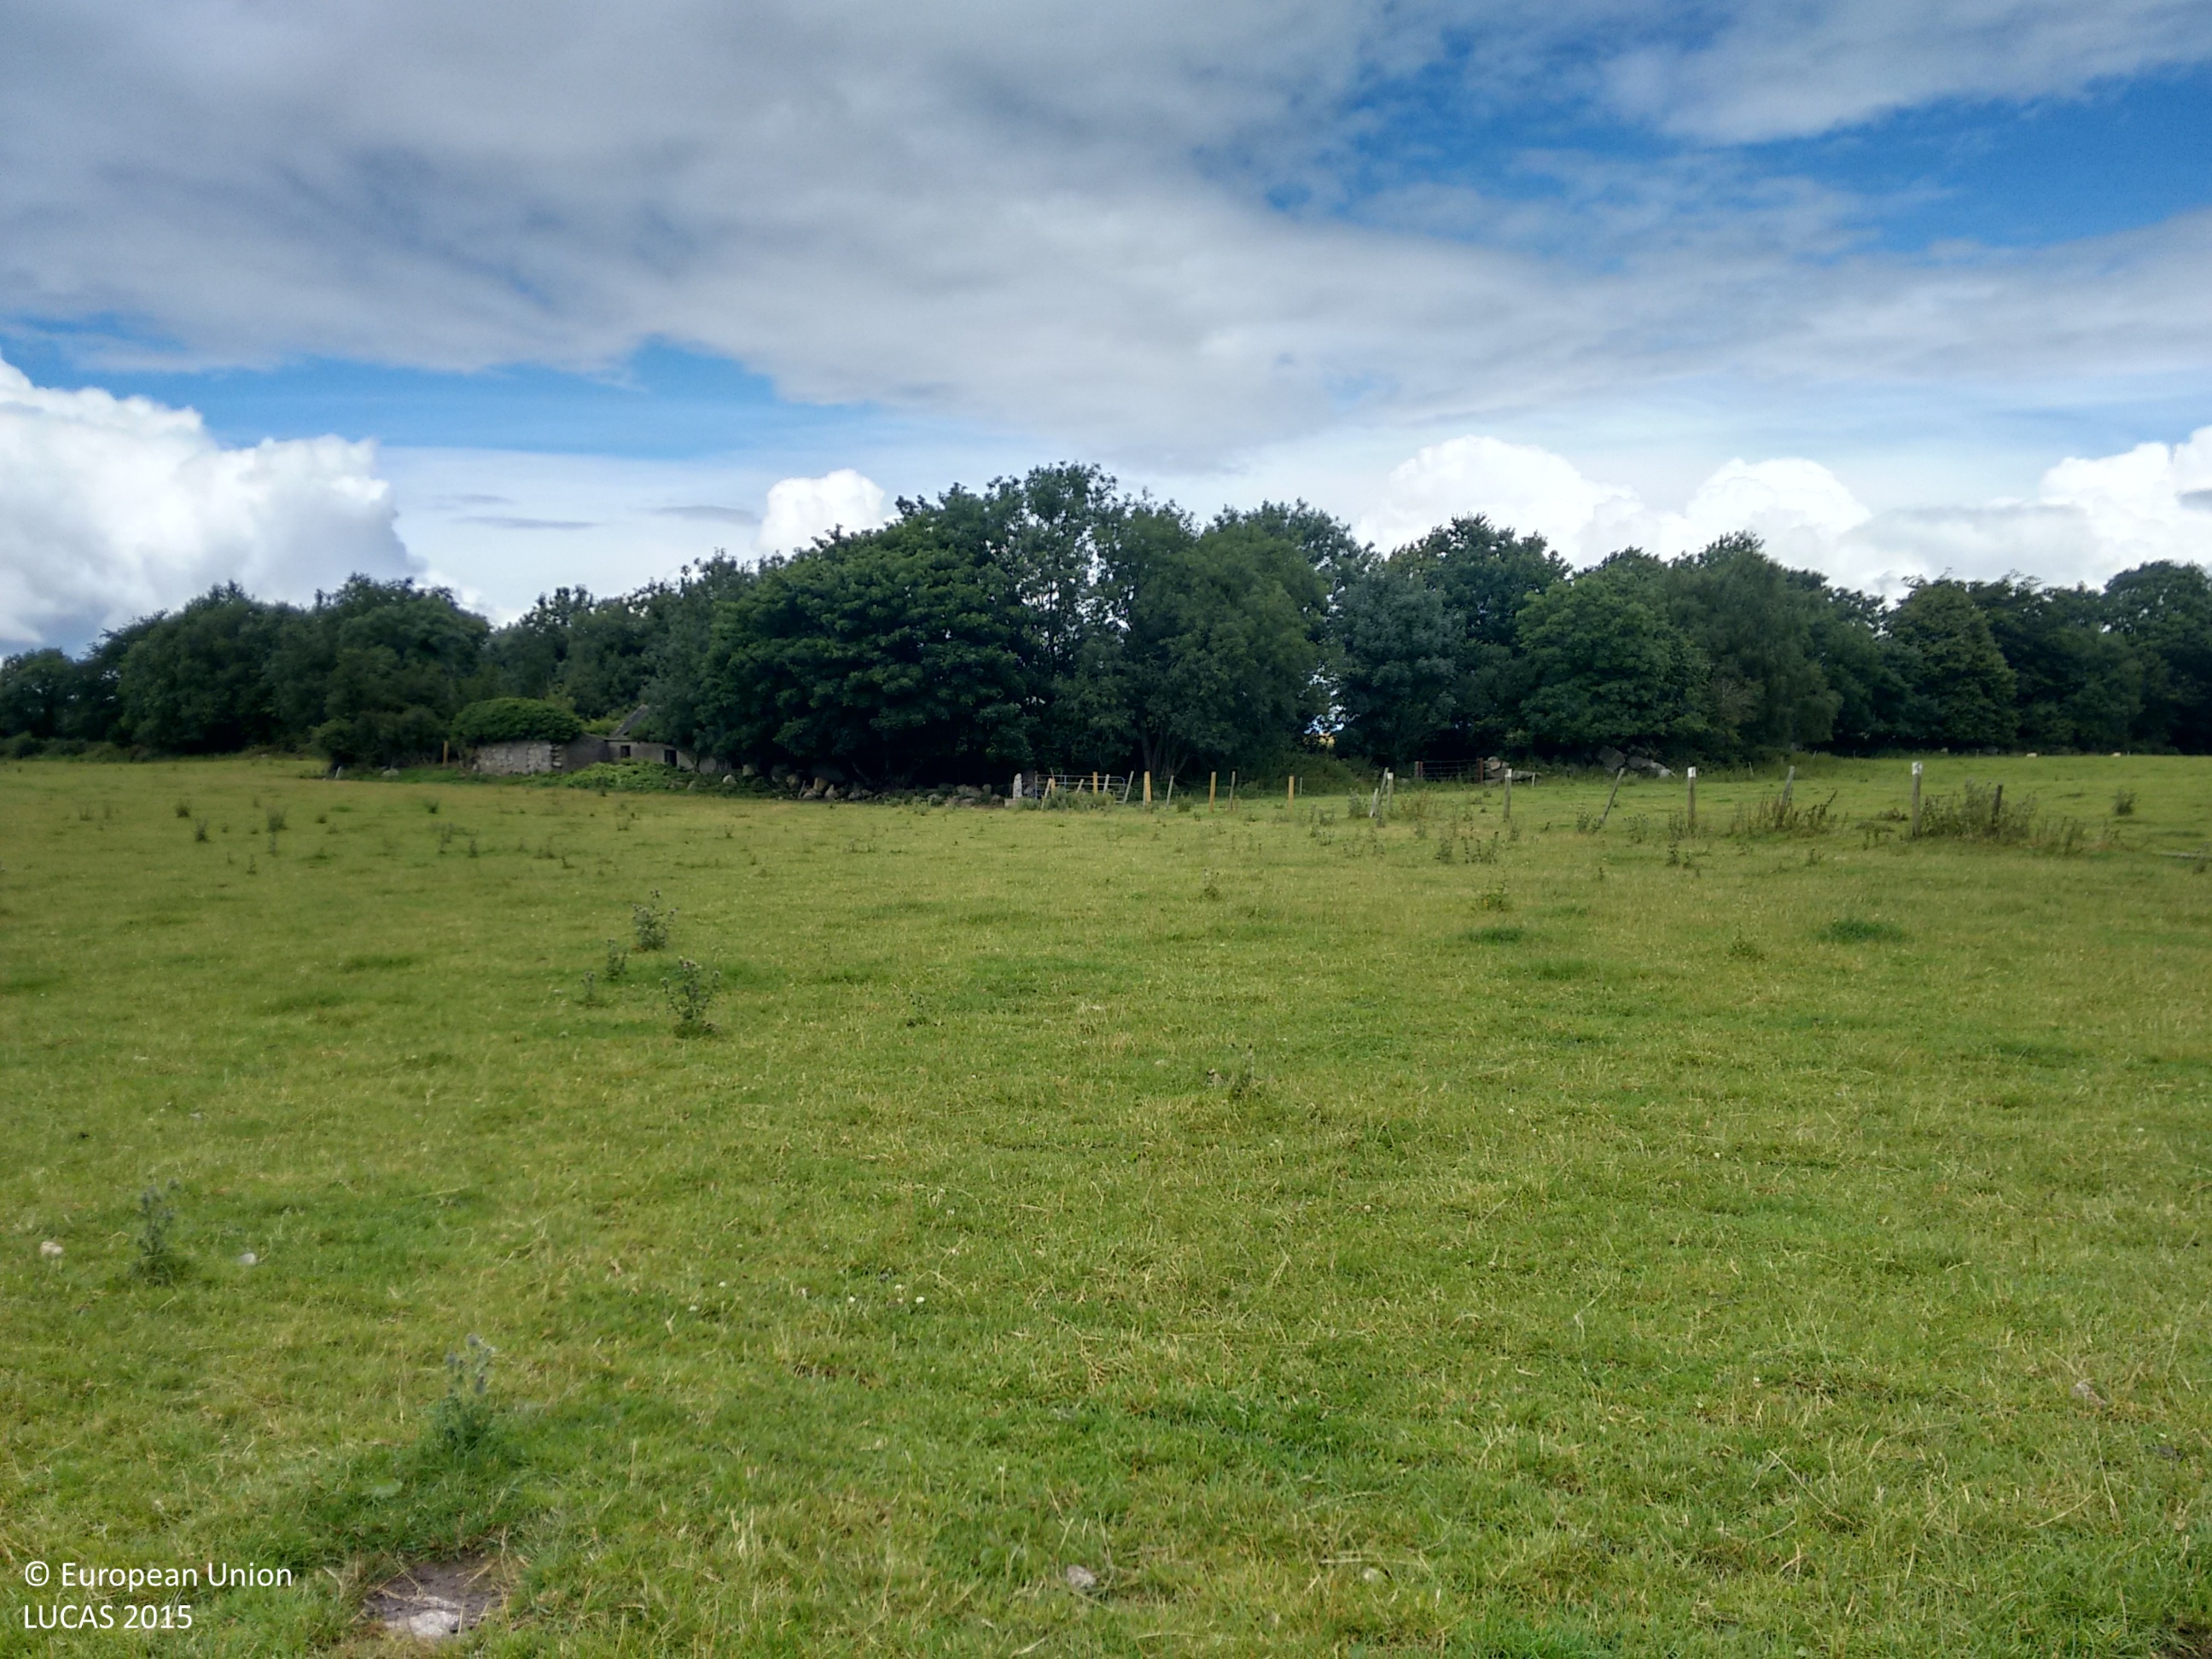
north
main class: Grassland
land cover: Grassland without tree/shrub cover
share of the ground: > 75 %
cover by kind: herbaceous plants 95 %, unconsolidated bare surface 5 %
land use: Agriculture (excluding fallow land and kitchen gardens)
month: July
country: IE
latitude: 52.7609
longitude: -6.7162
